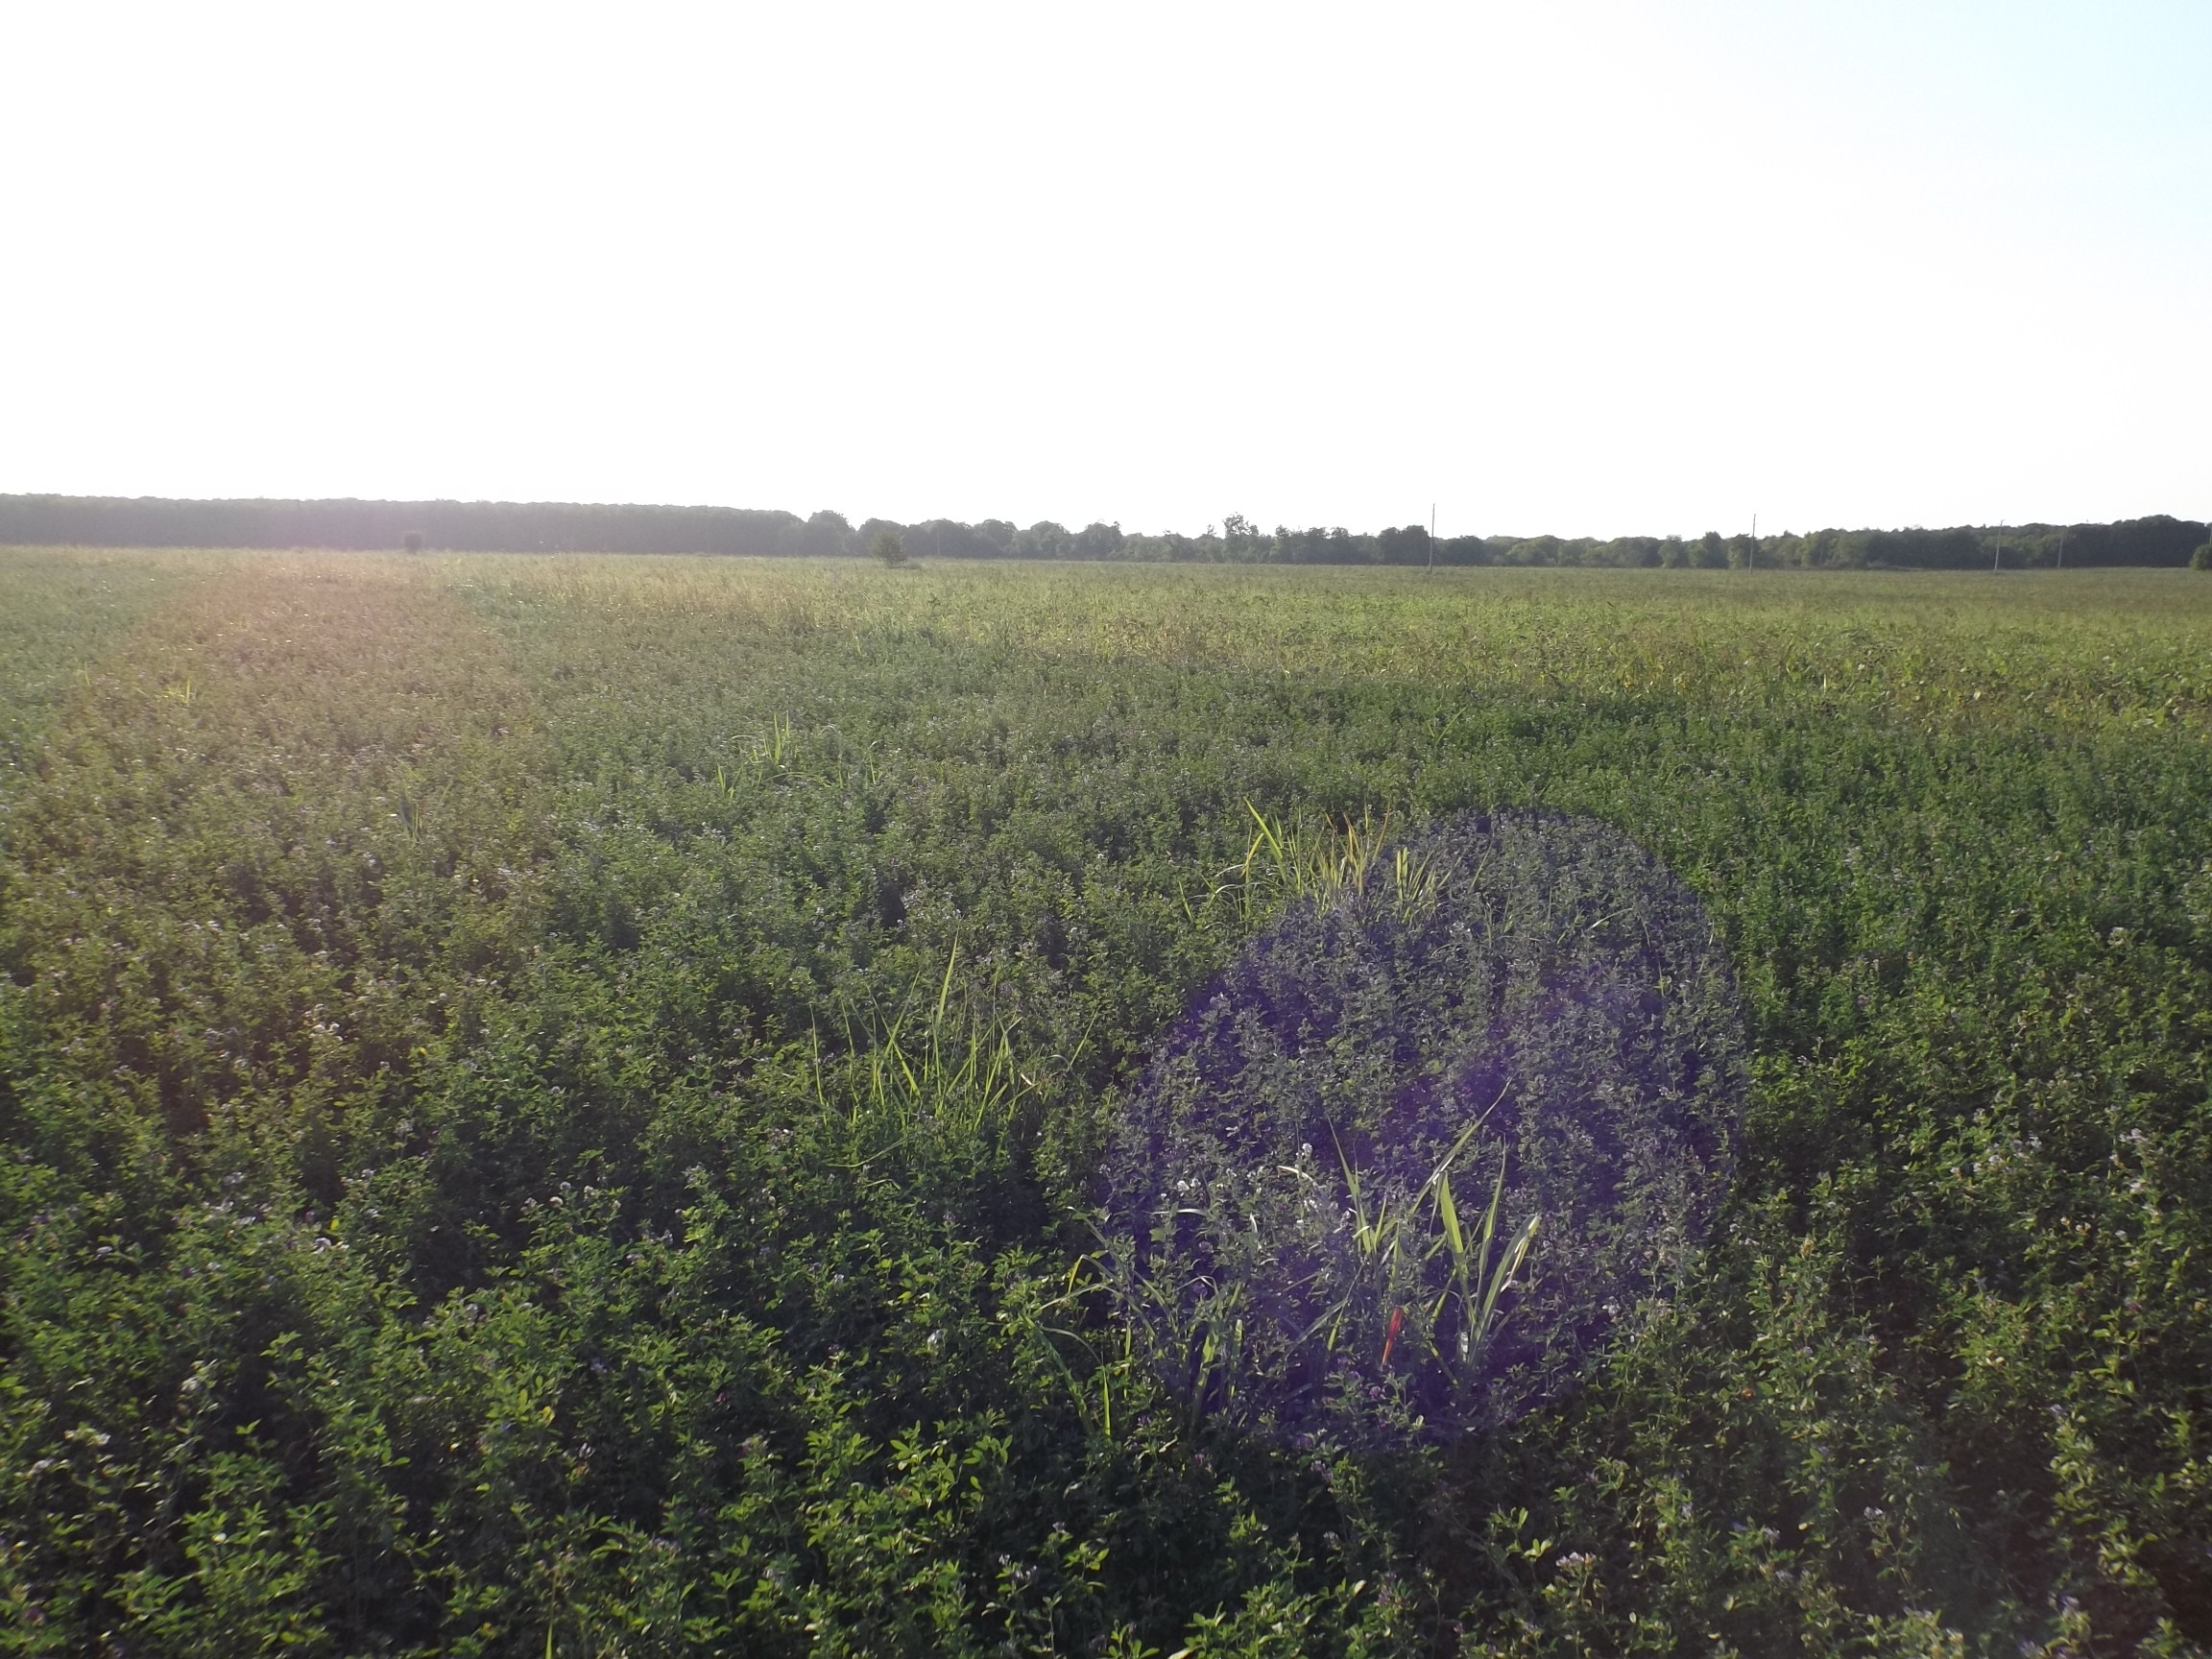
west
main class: Cropland
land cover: Lucerne
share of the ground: > 75 %
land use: Agriculture (excluding fallow land and kitchen gardens)
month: September
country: BG
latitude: 43.9948
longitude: 26.7130
